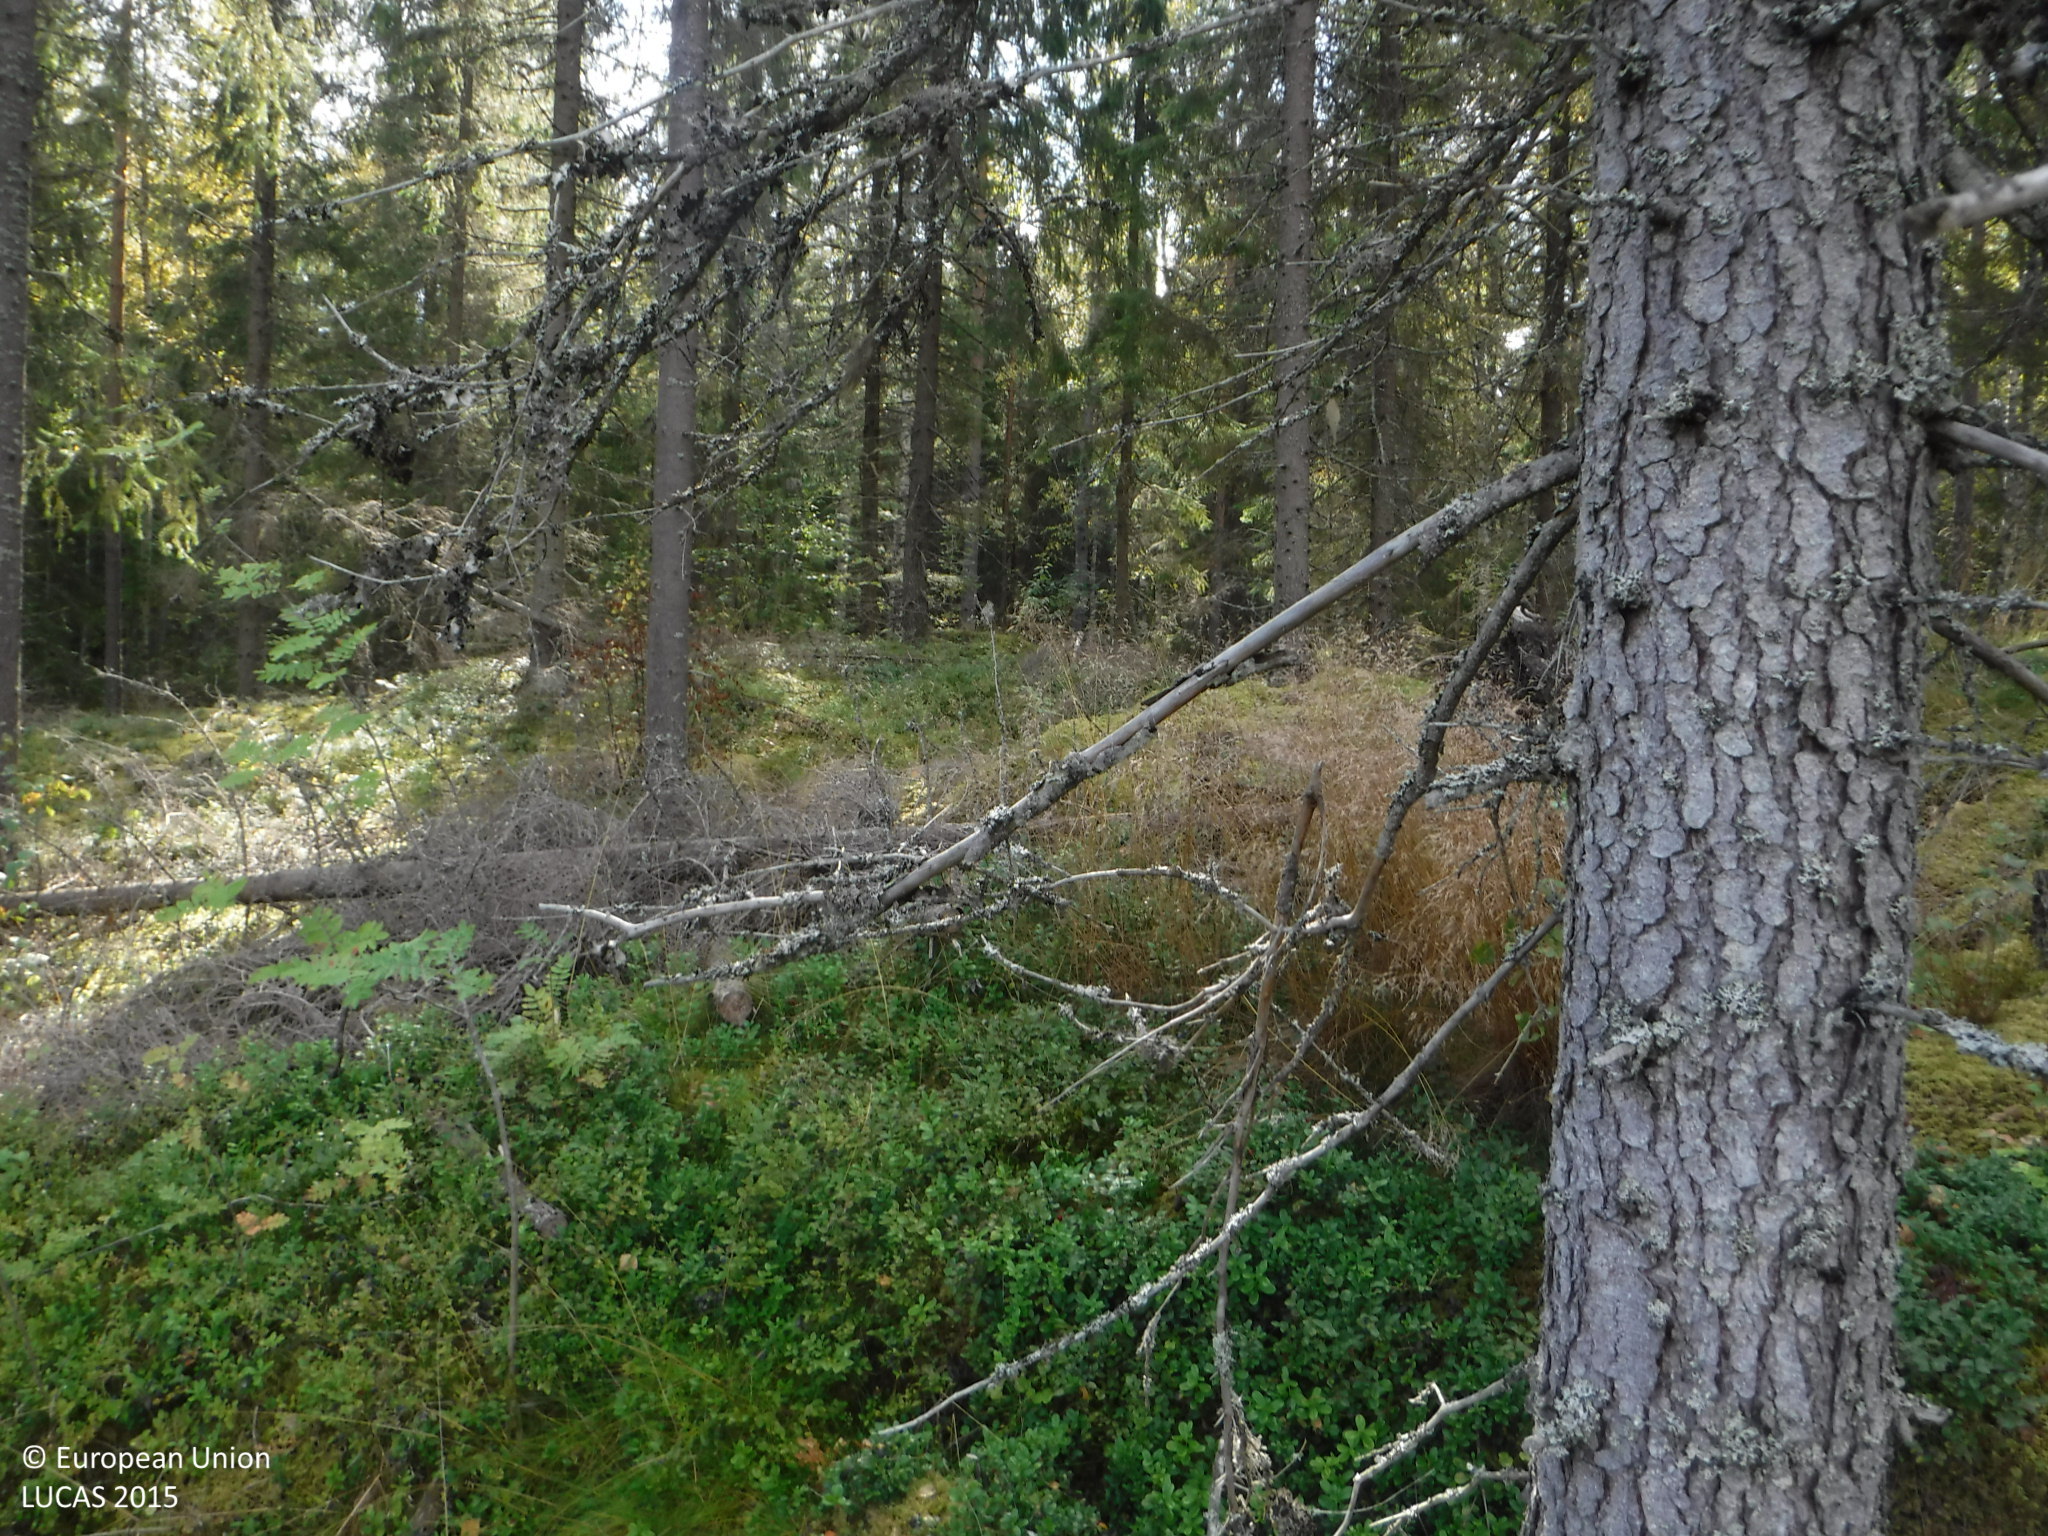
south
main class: Woodland
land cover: Spruce dominated coniferous woodland
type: boreal forest
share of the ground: 25 - 50 %
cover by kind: lichens and mosses 45 %, coniferous forest trees 40 %, shrubs 15 %
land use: Forestry
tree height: > 5 m
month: September
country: FI
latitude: 61.7332
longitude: 22.3825
